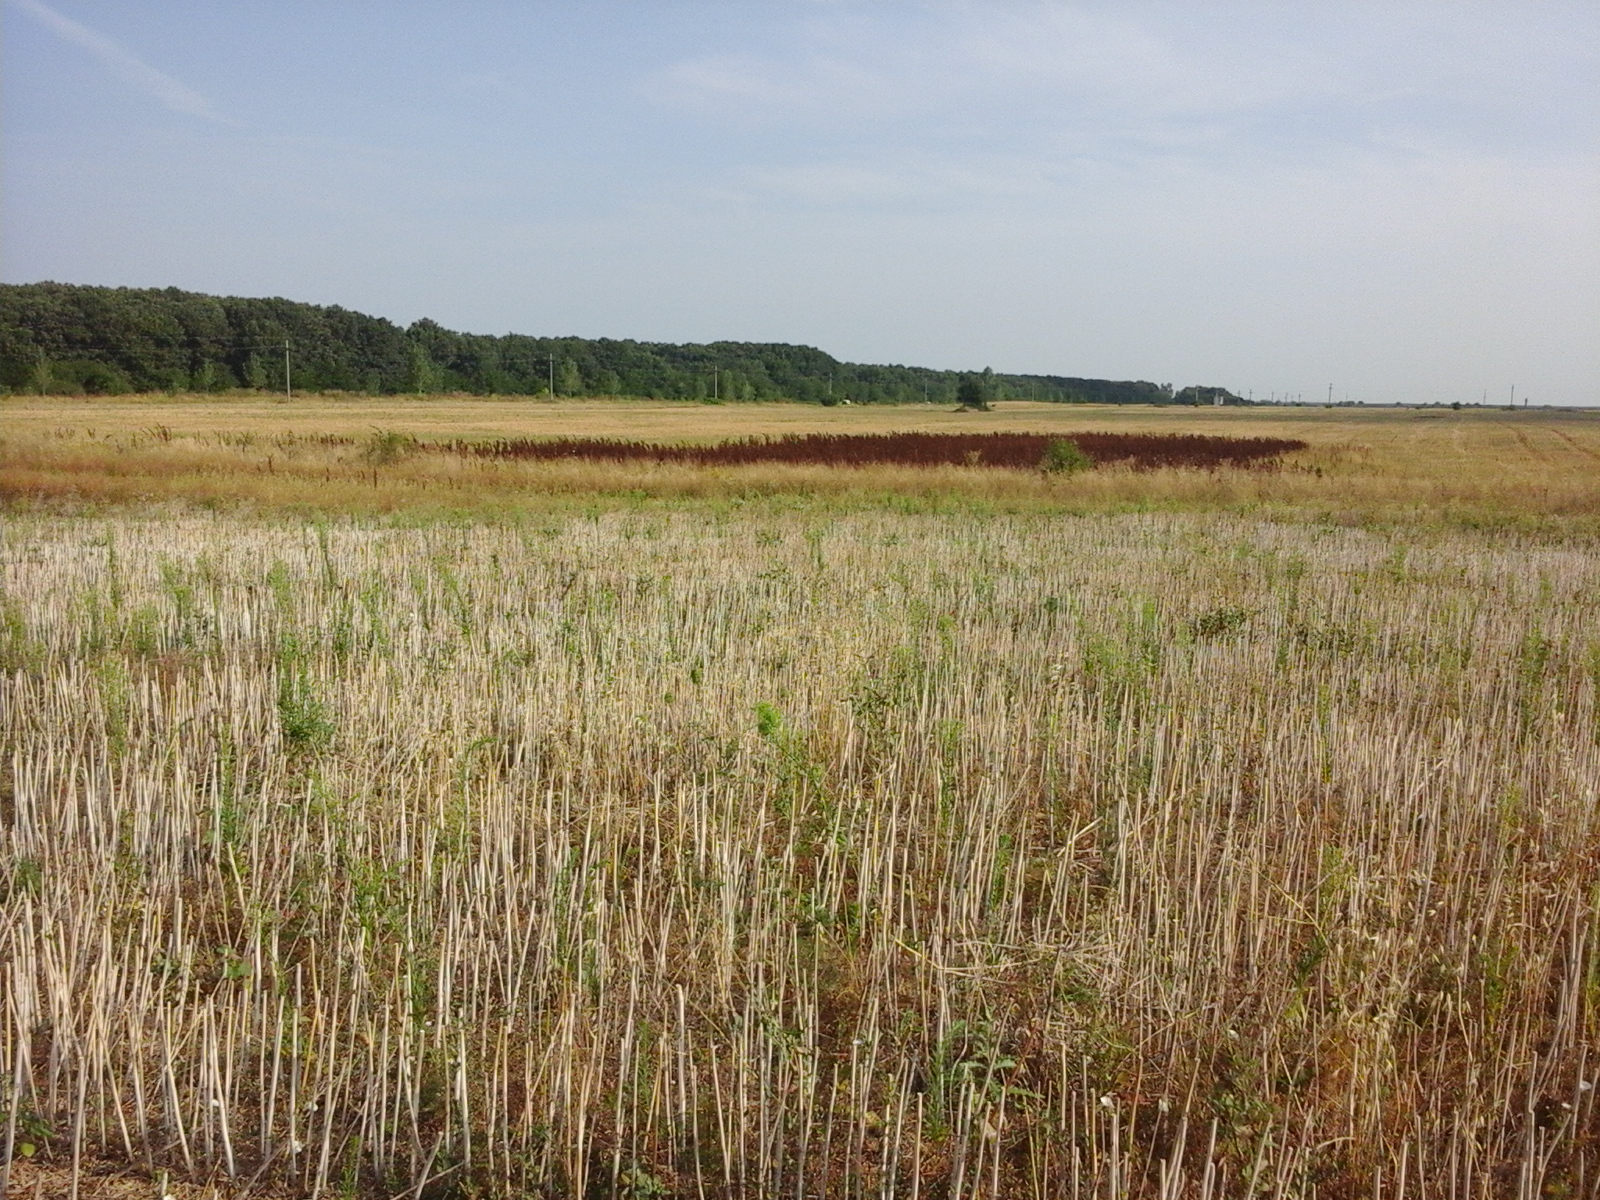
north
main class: Cropland
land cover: Rape and turnip rape
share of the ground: > 75 %
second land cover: Spontaneously vegetated surfaces
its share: 50 - 75 %
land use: Agriculture (excluding fallow land and kitchen gardens)
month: August
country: RO
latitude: 44.1439
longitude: 23.7431
